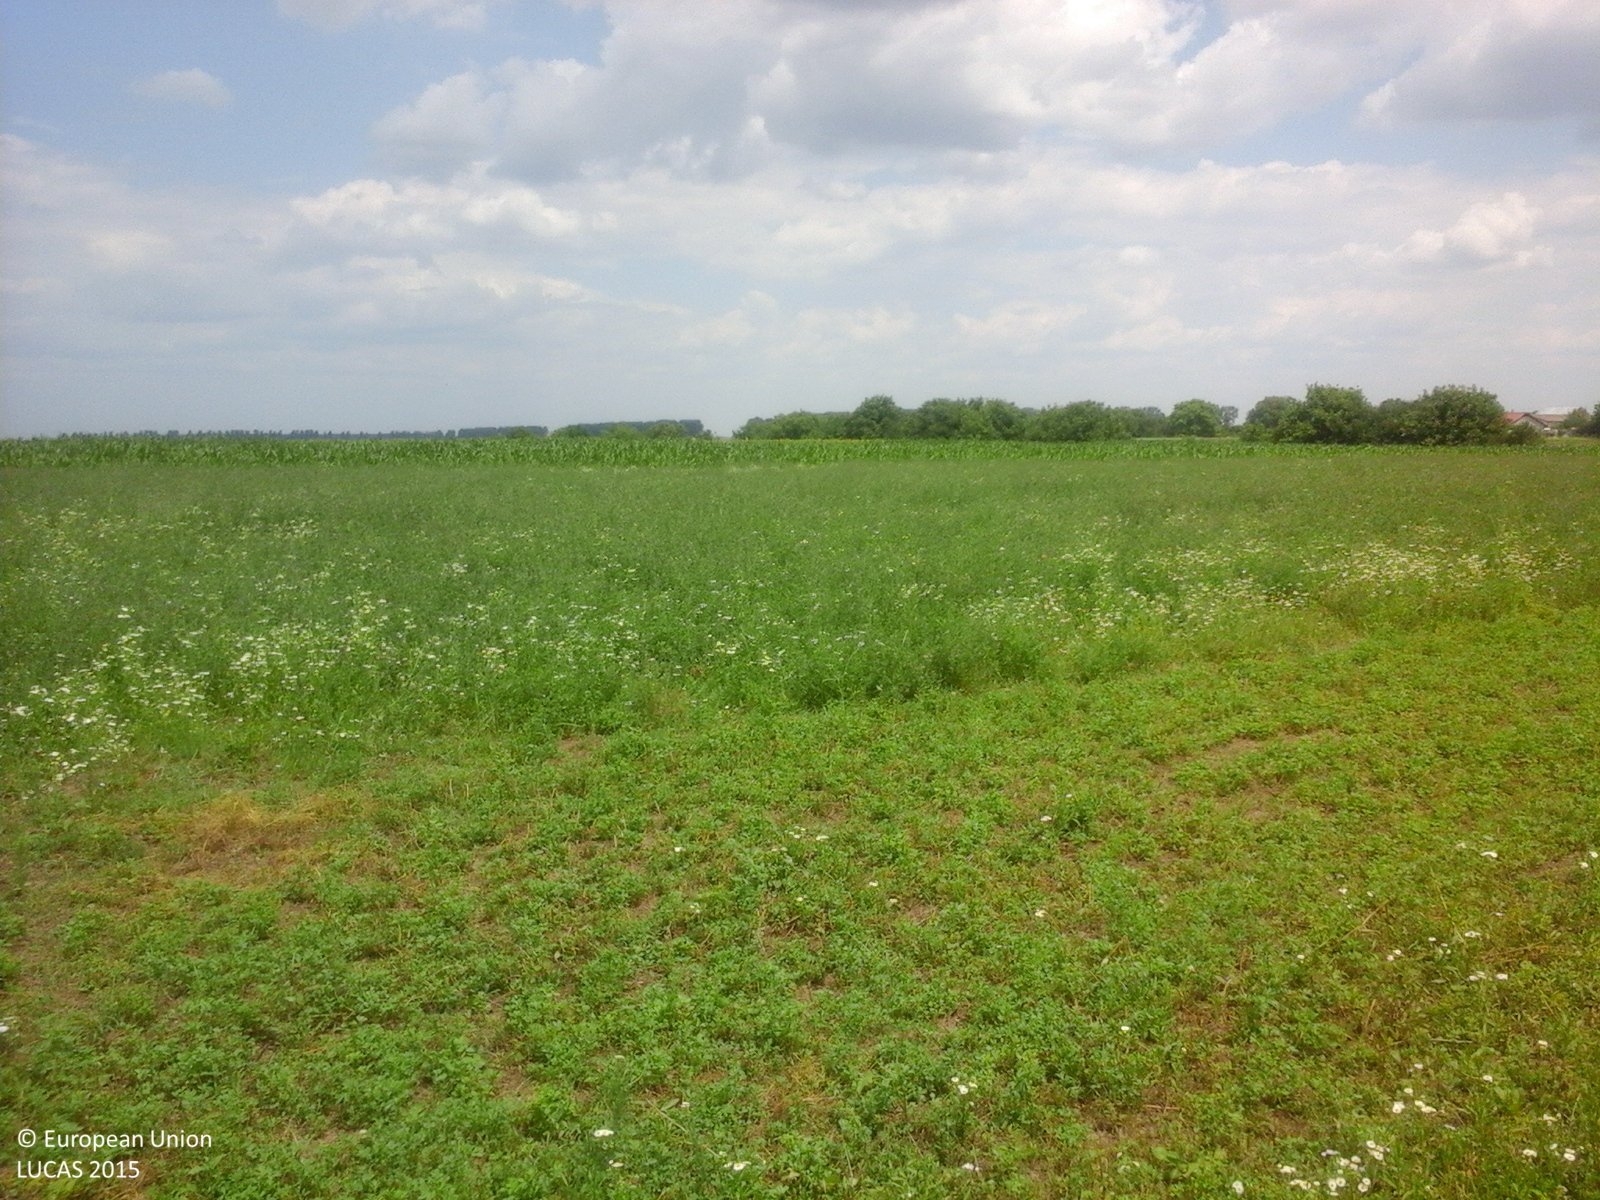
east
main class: Grassland
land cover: Grassland without tree/shrub cover
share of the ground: > 75 %
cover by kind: herbaceous plants 100 %
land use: Agriculture (excluding fallow land and kitchen gardens)
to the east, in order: Grassland without tree/shrub cover; Lucerne; Maize; Grass margins; Sunflower; Grassland without tree/shrub cover; Tracks; Grass margins; Ditches and canals; Abandoned hedges
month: June
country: RO
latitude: 44.6198
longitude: 26.2549
